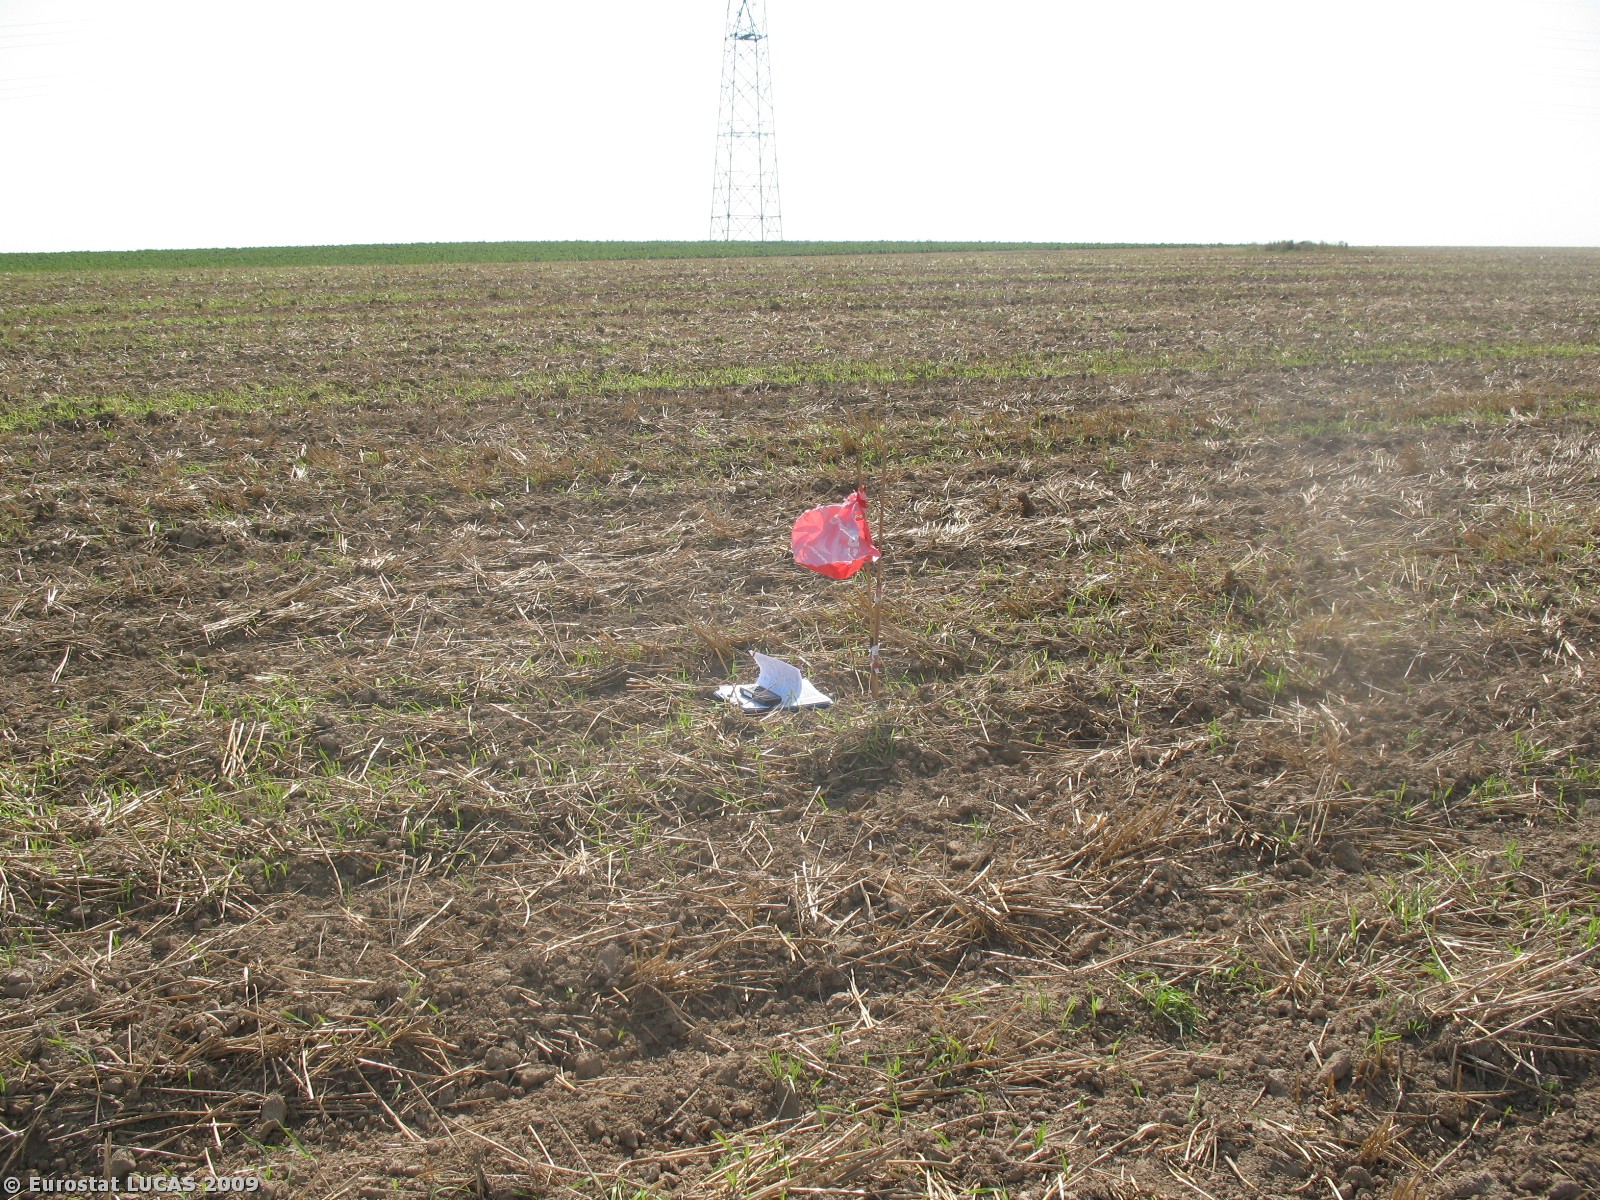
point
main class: Cropland
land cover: Common wheat
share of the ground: > 75 %
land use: Agriculture (excluding fallow land and kitchen gardens)
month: August
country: BE
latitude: 50.5303
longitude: 4.3383
